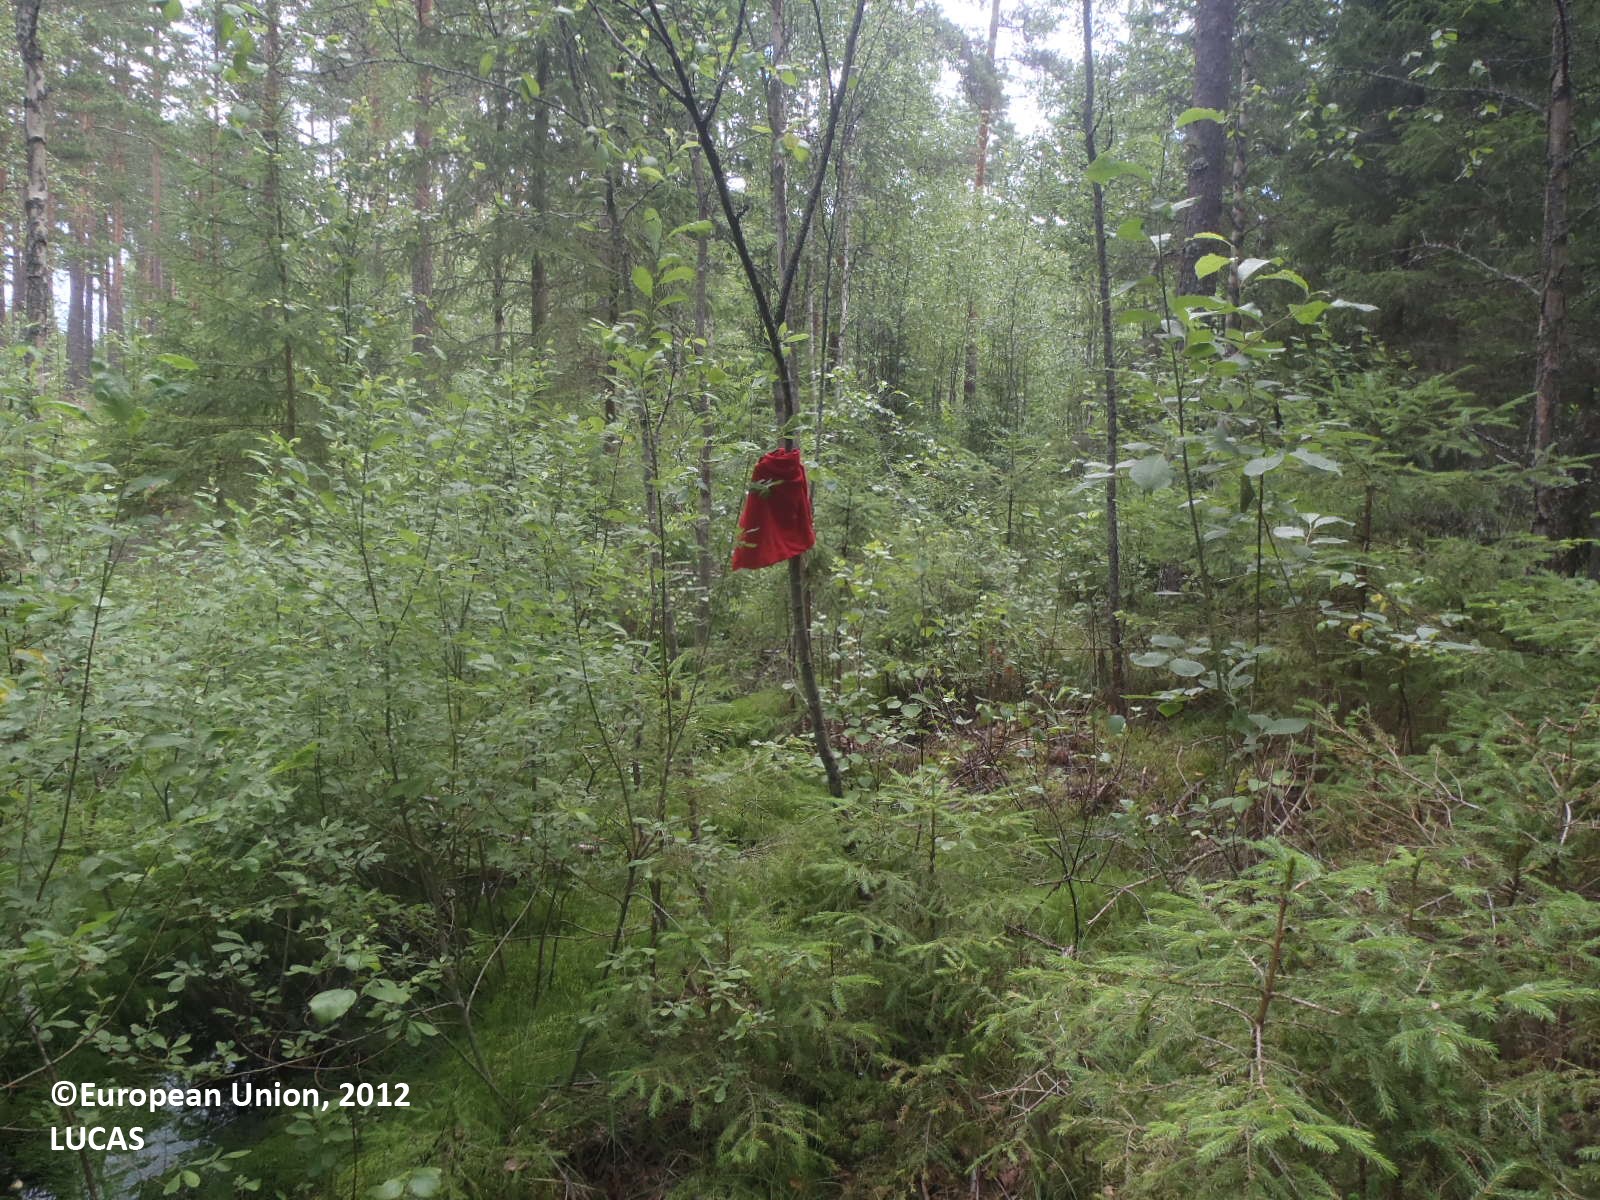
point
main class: Woodland
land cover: Spruce dominated mixed woodland
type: boreal forest
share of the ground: 50 - 75 %
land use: Forestry
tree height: > 5 m
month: July
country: FI
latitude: 60.9760
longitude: 21.8276
